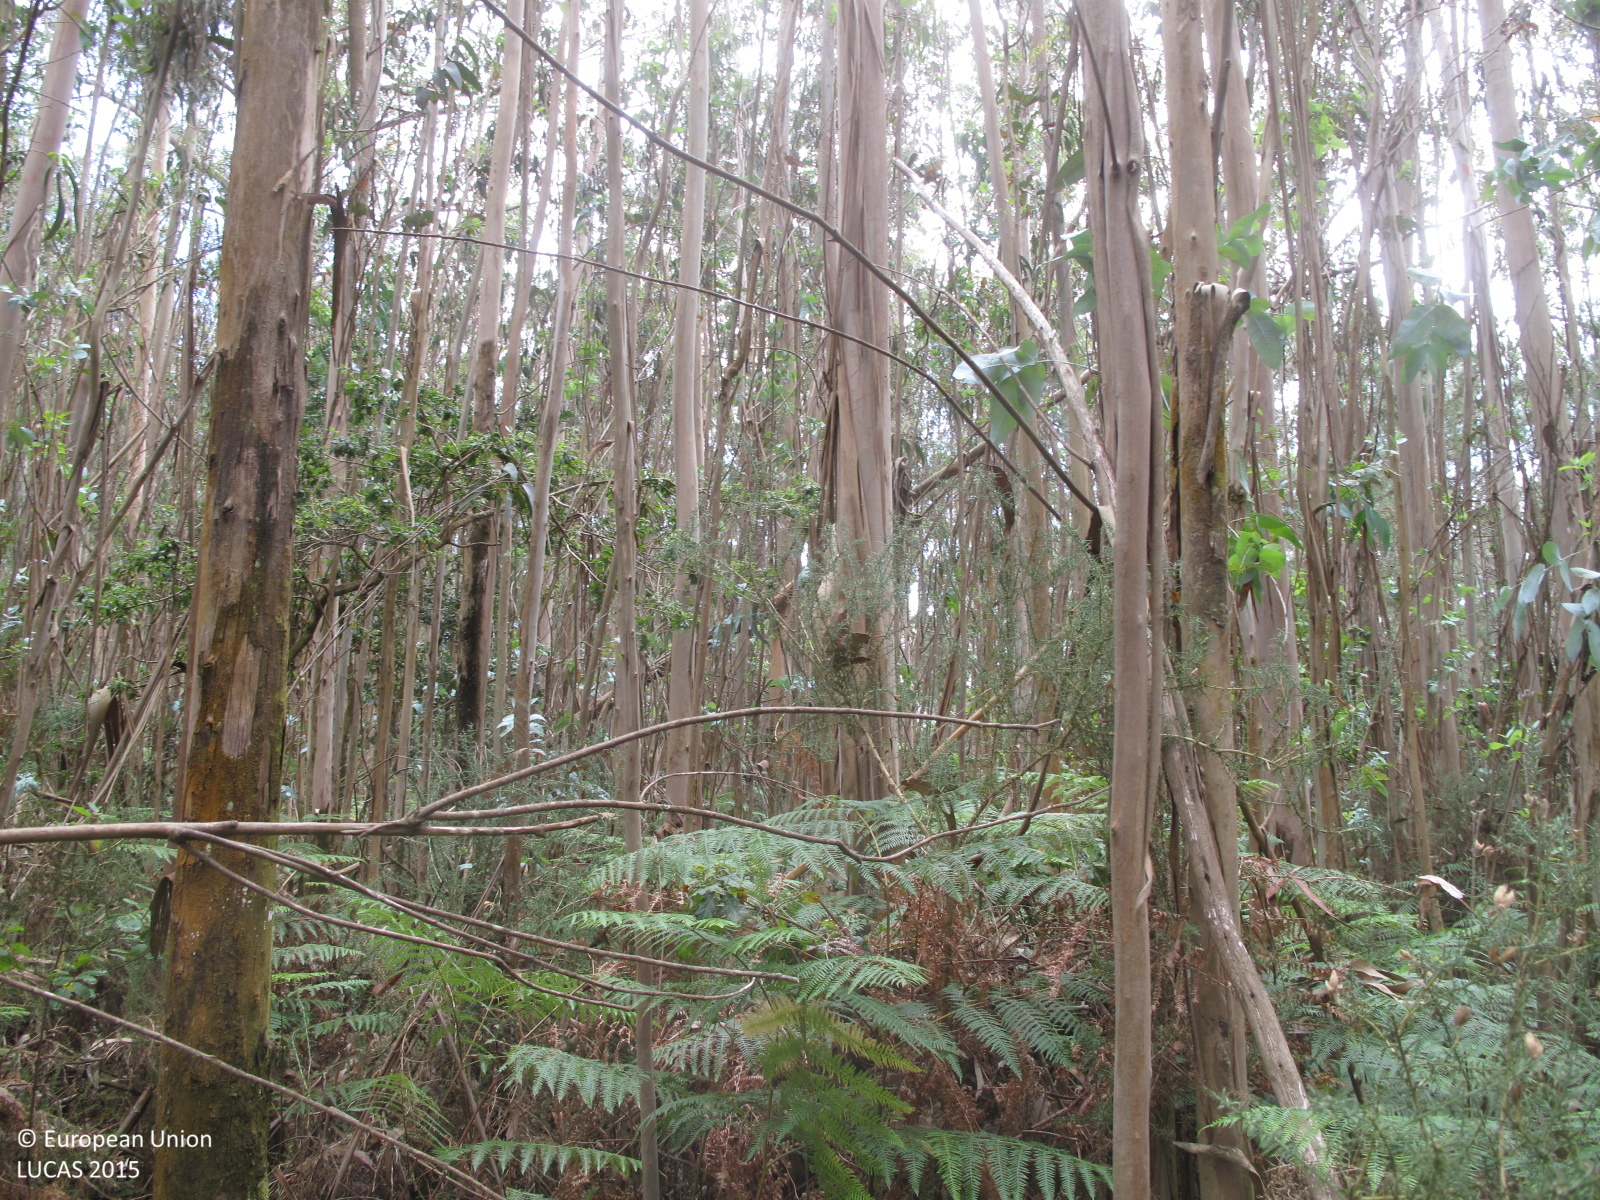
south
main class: Woodland
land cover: Broadleaved woodland
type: exotic forest
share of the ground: 50 - 75 %
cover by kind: broadleaved forest trees 60 %, herbaceous plants 20 %, shrubs 10 %, unconsolidated bare surface 10 %
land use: Forestry
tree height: > 5 m
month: July
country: ES
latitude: 42.9419
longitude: -9.2087
